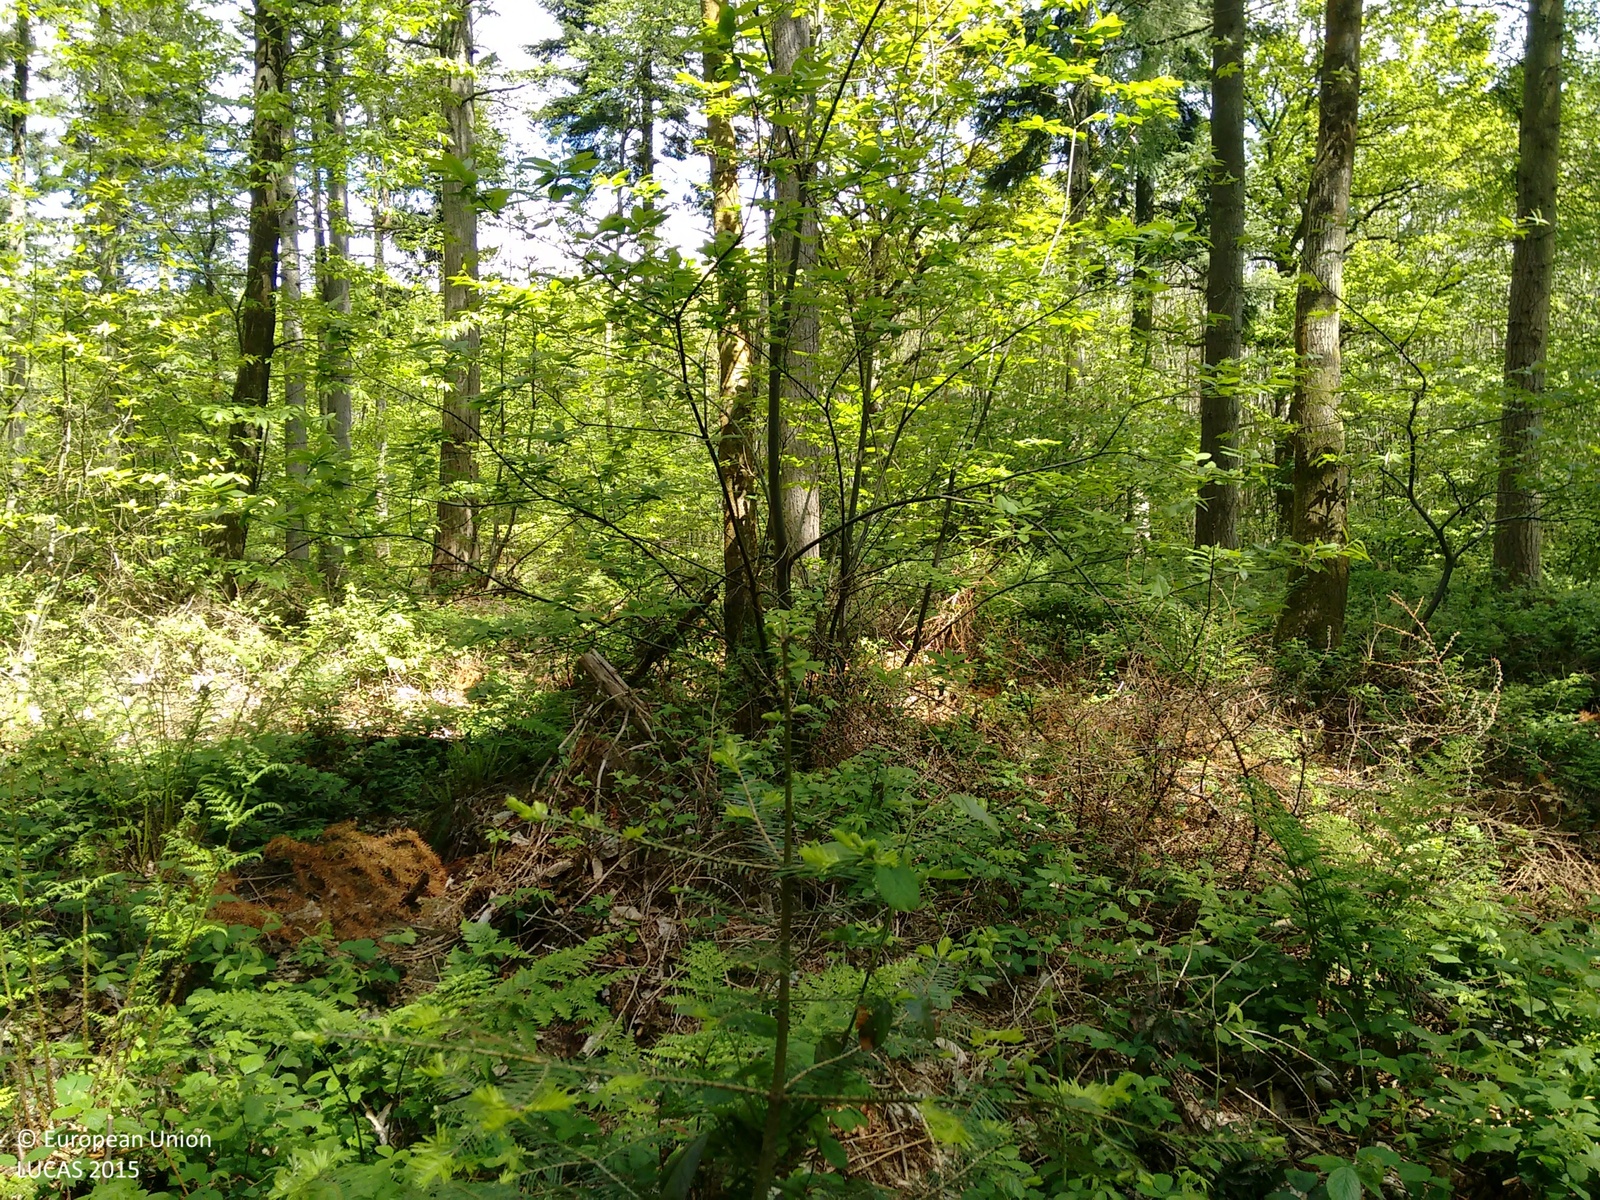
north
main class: Woodland
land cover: Spruce dominated mixed woodland
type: exotic forest
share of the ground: > 75 %
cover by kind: coniferous forest trees 75 %, broadleaved forest trees 25 %
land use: Forestry
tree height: > 5 m
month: May
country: GB
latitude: 51.1740
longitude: 1.0950
